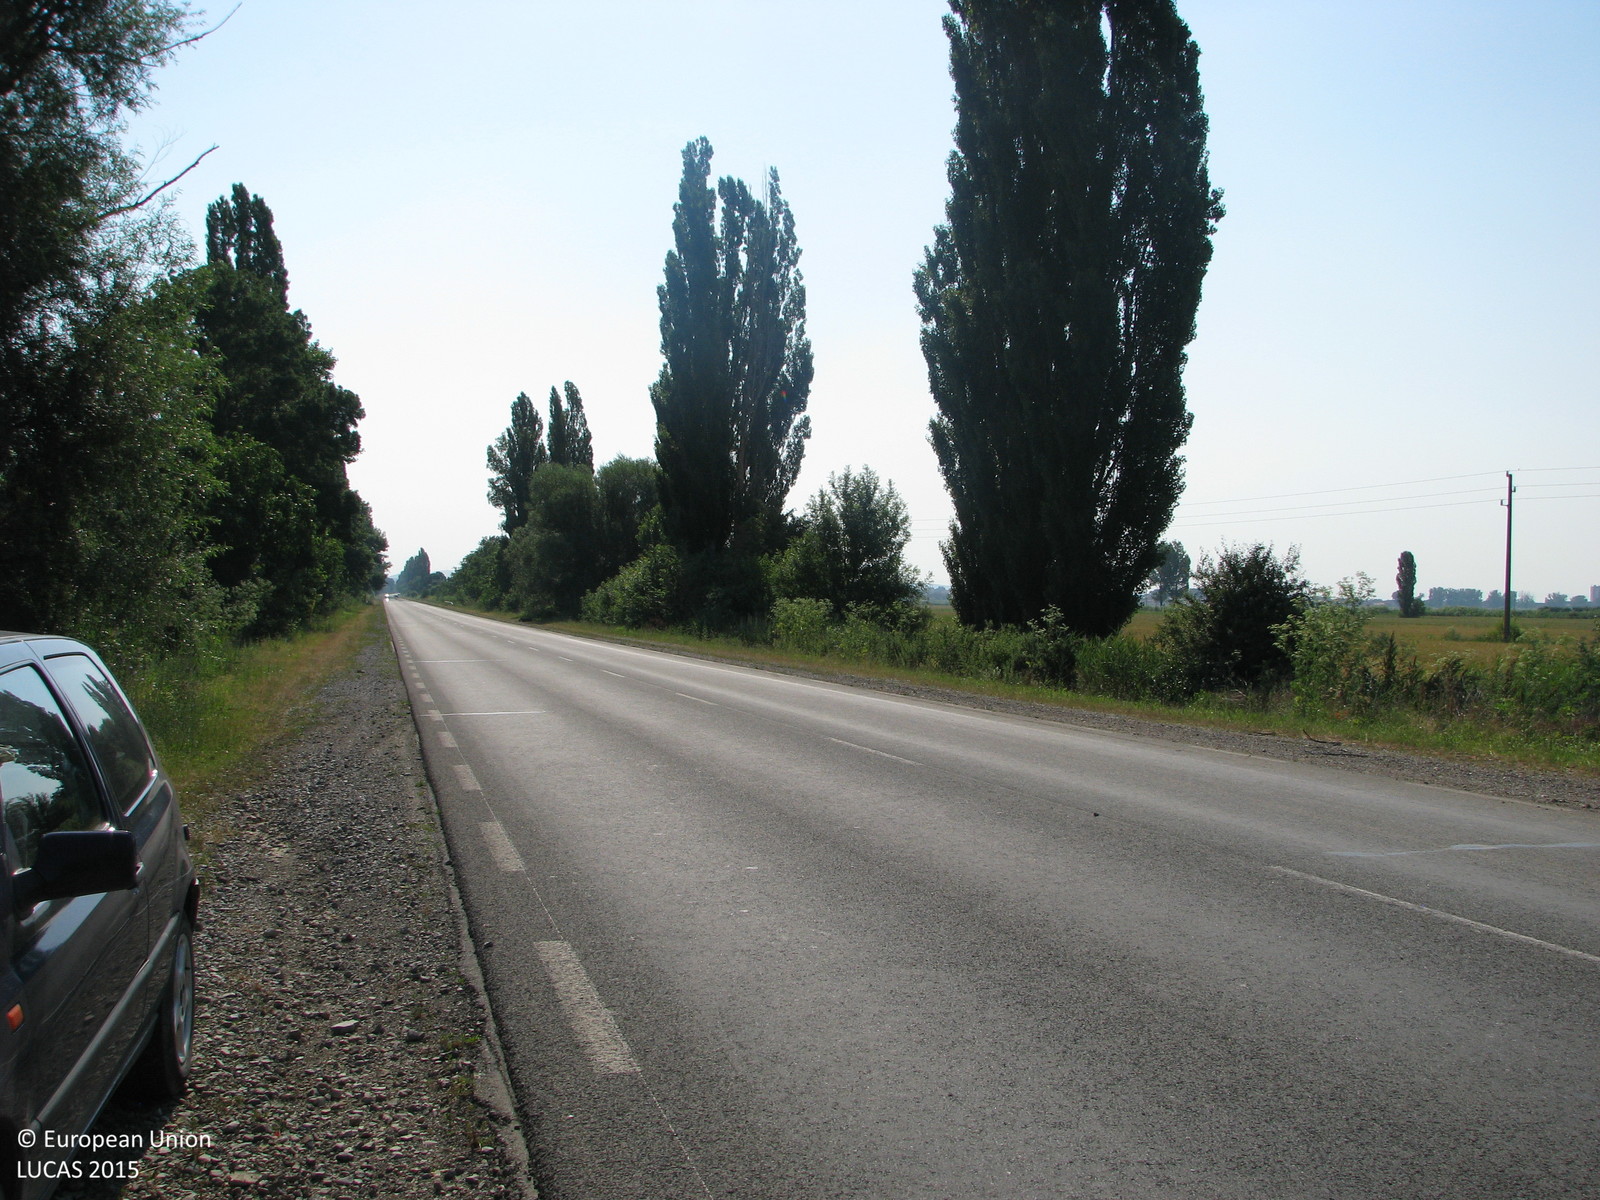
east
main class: Grassland
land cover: Grassland with sparse tree/shrub cover
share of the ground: > 75 %
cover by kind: herbaceous plants 90 %, coniferous forest trees 5 %, shrubs 5 %
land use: Abandoned areas
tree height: < 5 m
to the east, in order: Grass margins; Other bare soil; Paved roads, cycling and walking lanes; Other bare soil
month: June
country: BG
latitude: 42.6372
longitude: 26.2468
